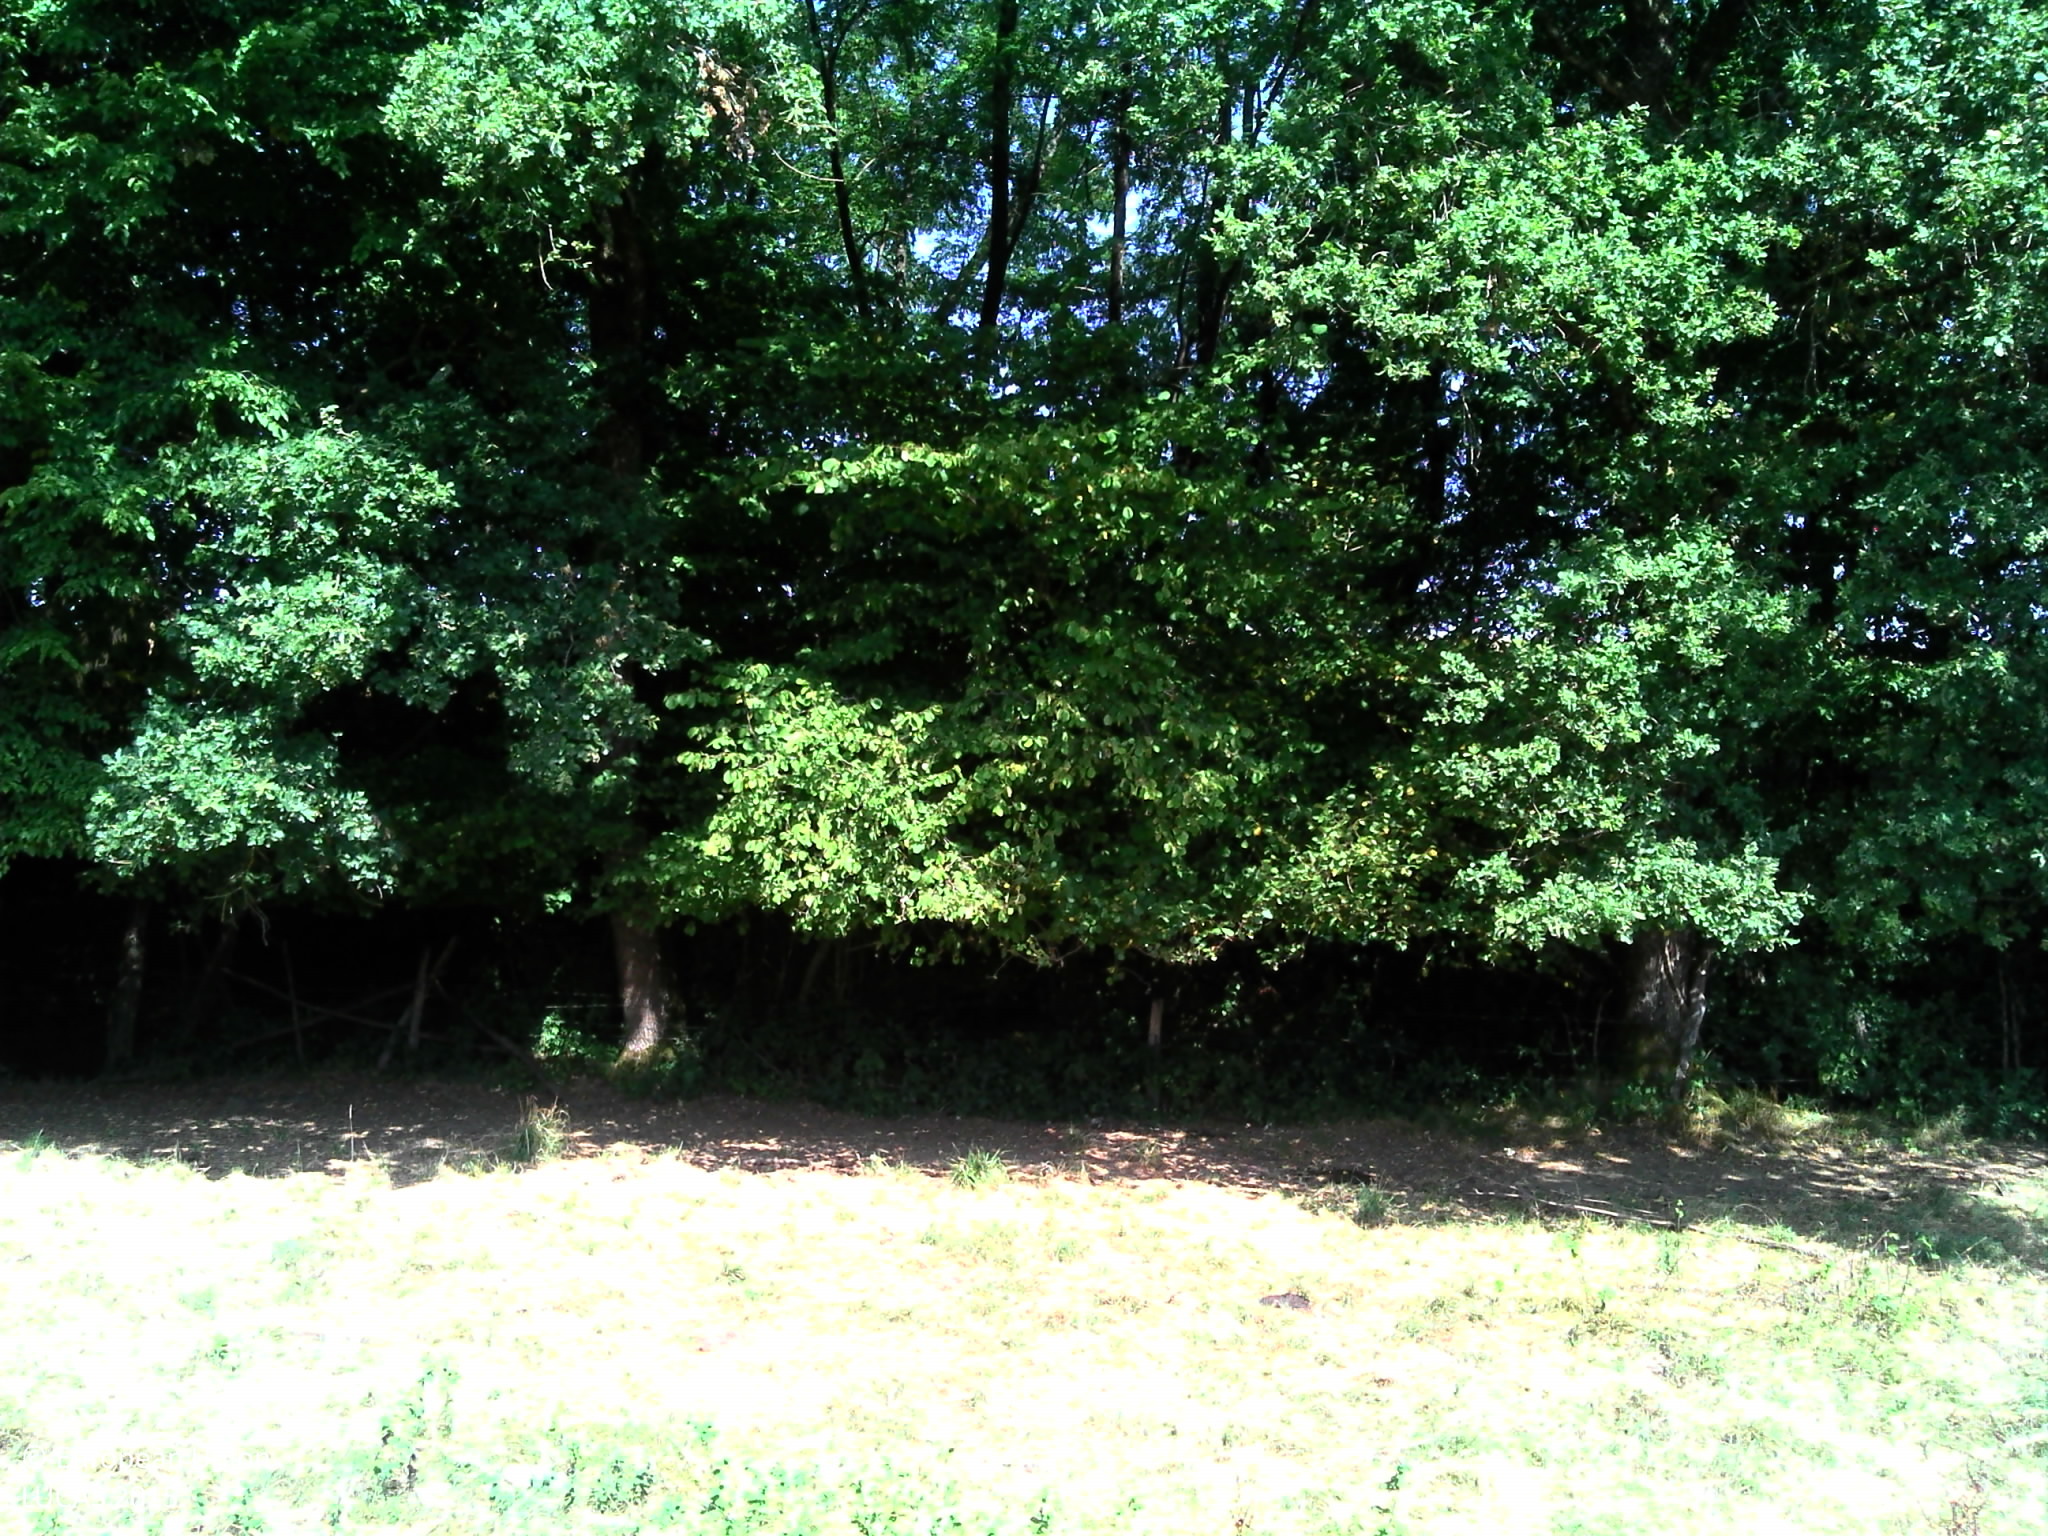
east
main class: Grassland
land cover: Grassland without tree/shrub cover
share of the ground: > 75 %
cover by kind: herbaceous plants 100 %
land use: Agriculture (excluding fallow land and kitchen gardens)
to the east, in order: Grassland without tree/shrub cover; Fences; Ditches and canals; Broadleaved woodland; Grassland without tree/shrub cover; Electric lines; Grassland without tree/shrub cover
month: August
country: FR
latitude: 45.3987
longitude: 1.0876
